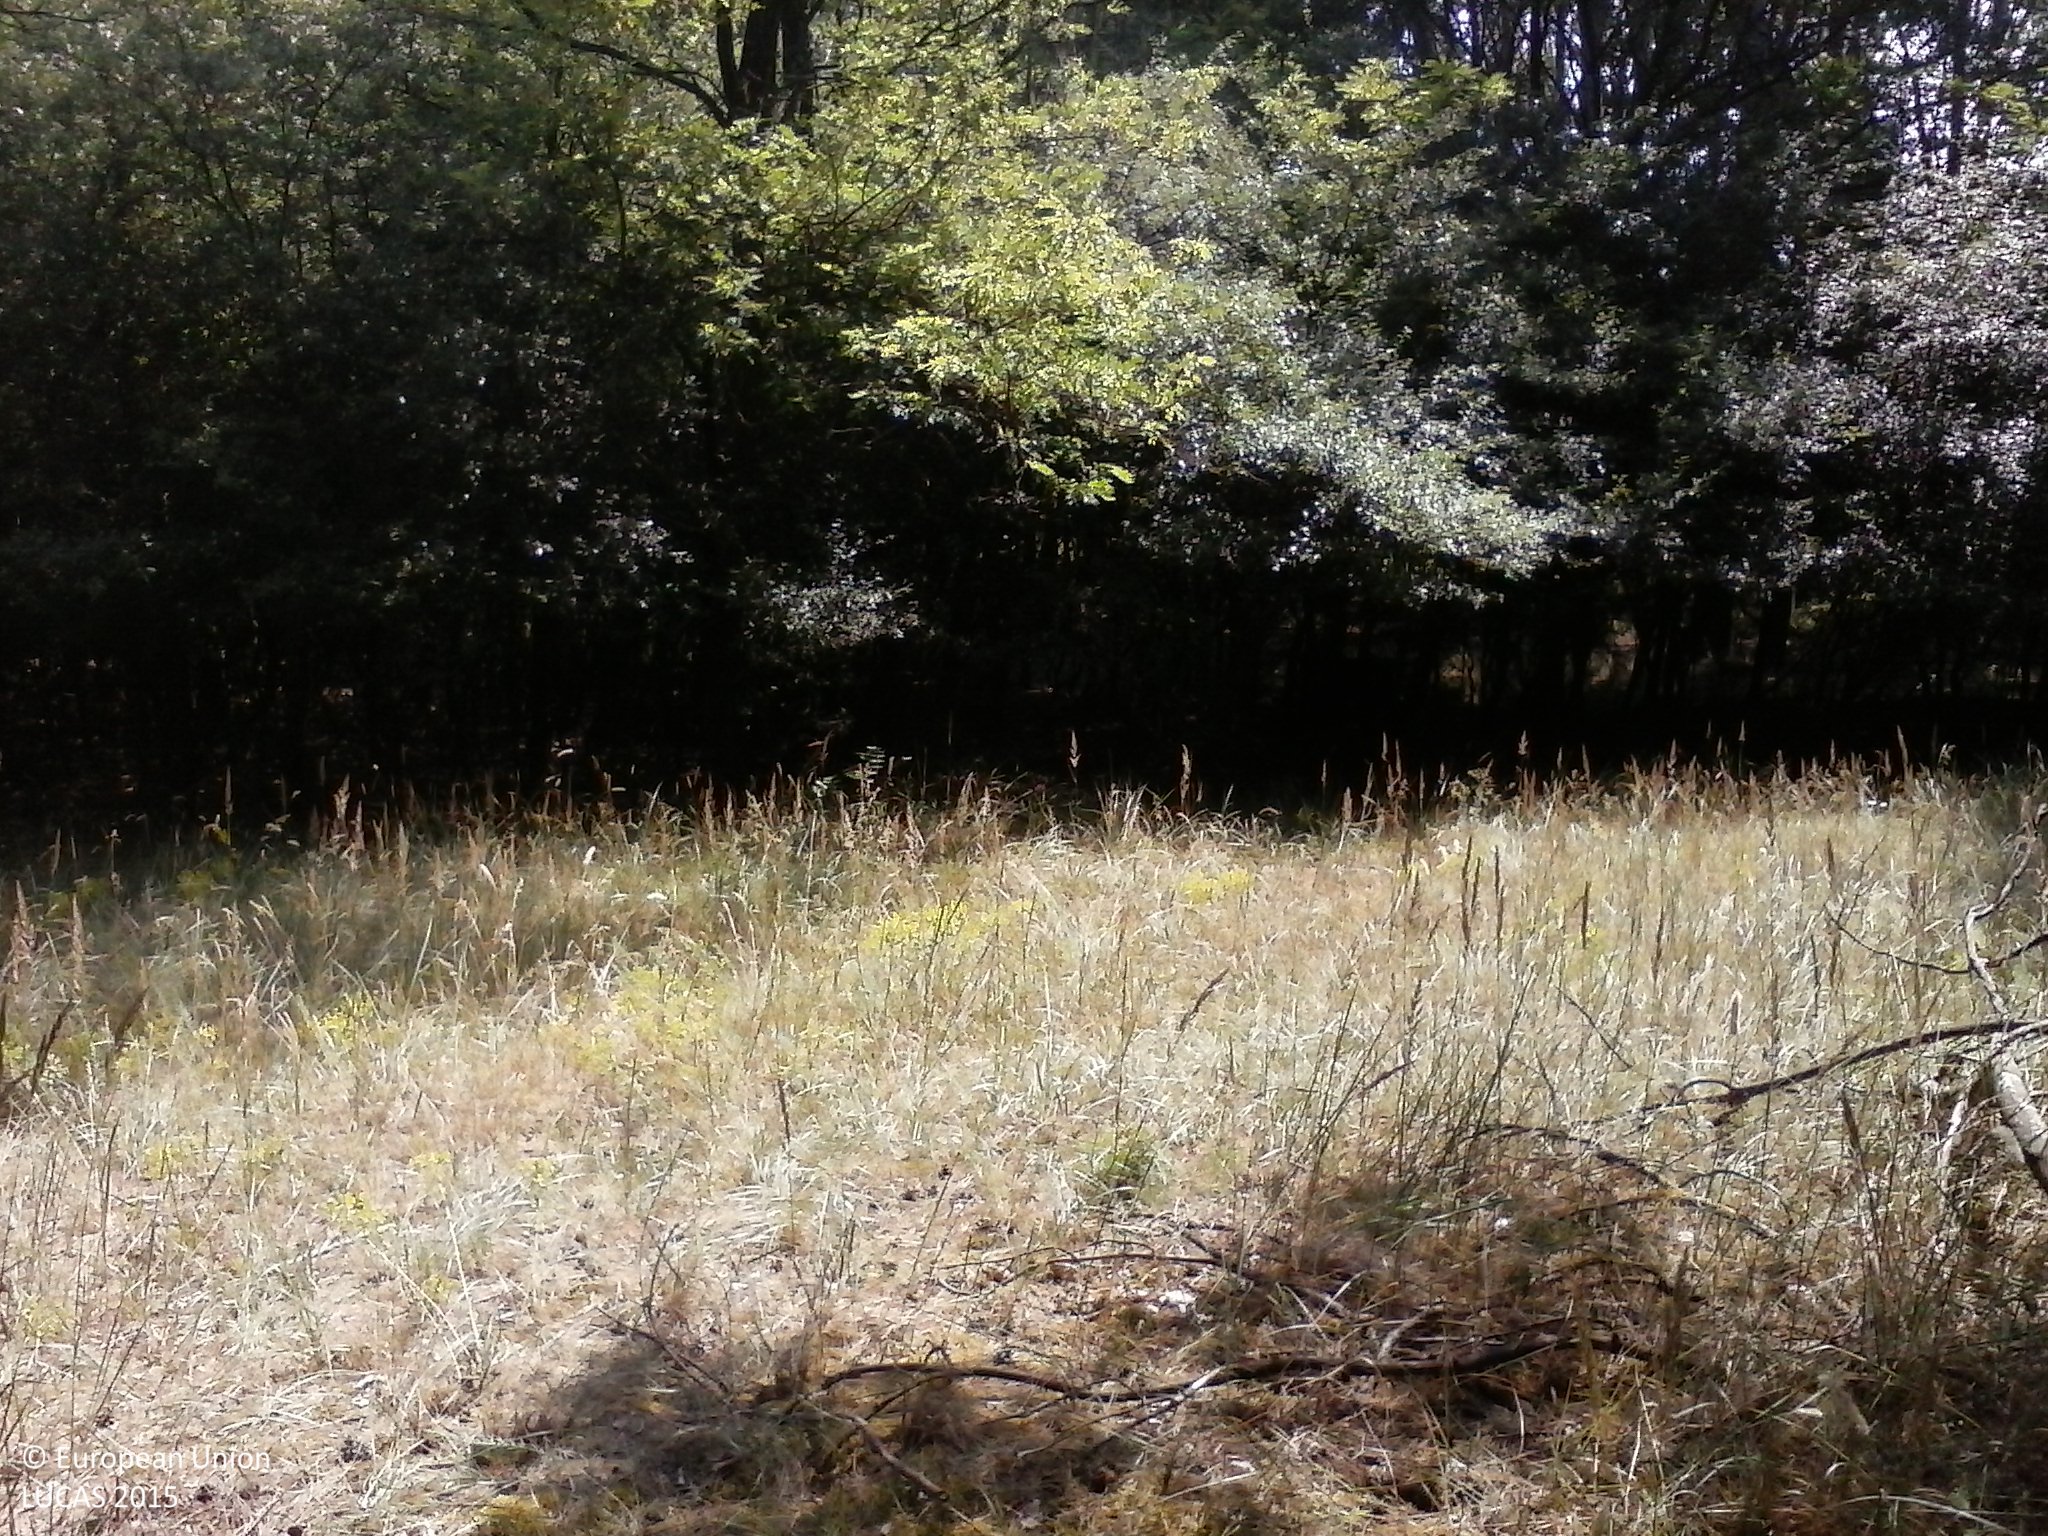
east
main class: Woodland
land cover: Pine dominated coniferous woodland
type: hemiboreal forest and nemoral coniferous forest and mixed broadleaved-coniferous forest
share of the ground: > 75 %
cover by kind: coniferous forest trees 90 %, shrubs 5 %, herbaceous plants 5 %
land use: Forestry
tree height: > 5 m
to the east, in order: Pine dominated coniferous woodland; Tracks; Spontaneously vegetated surfaces; Broadleaved woodland; Tracks; Grass margins; Spruce dominated mixed woodland
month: July
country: HU
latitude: 46.2804
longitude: 19.6082
